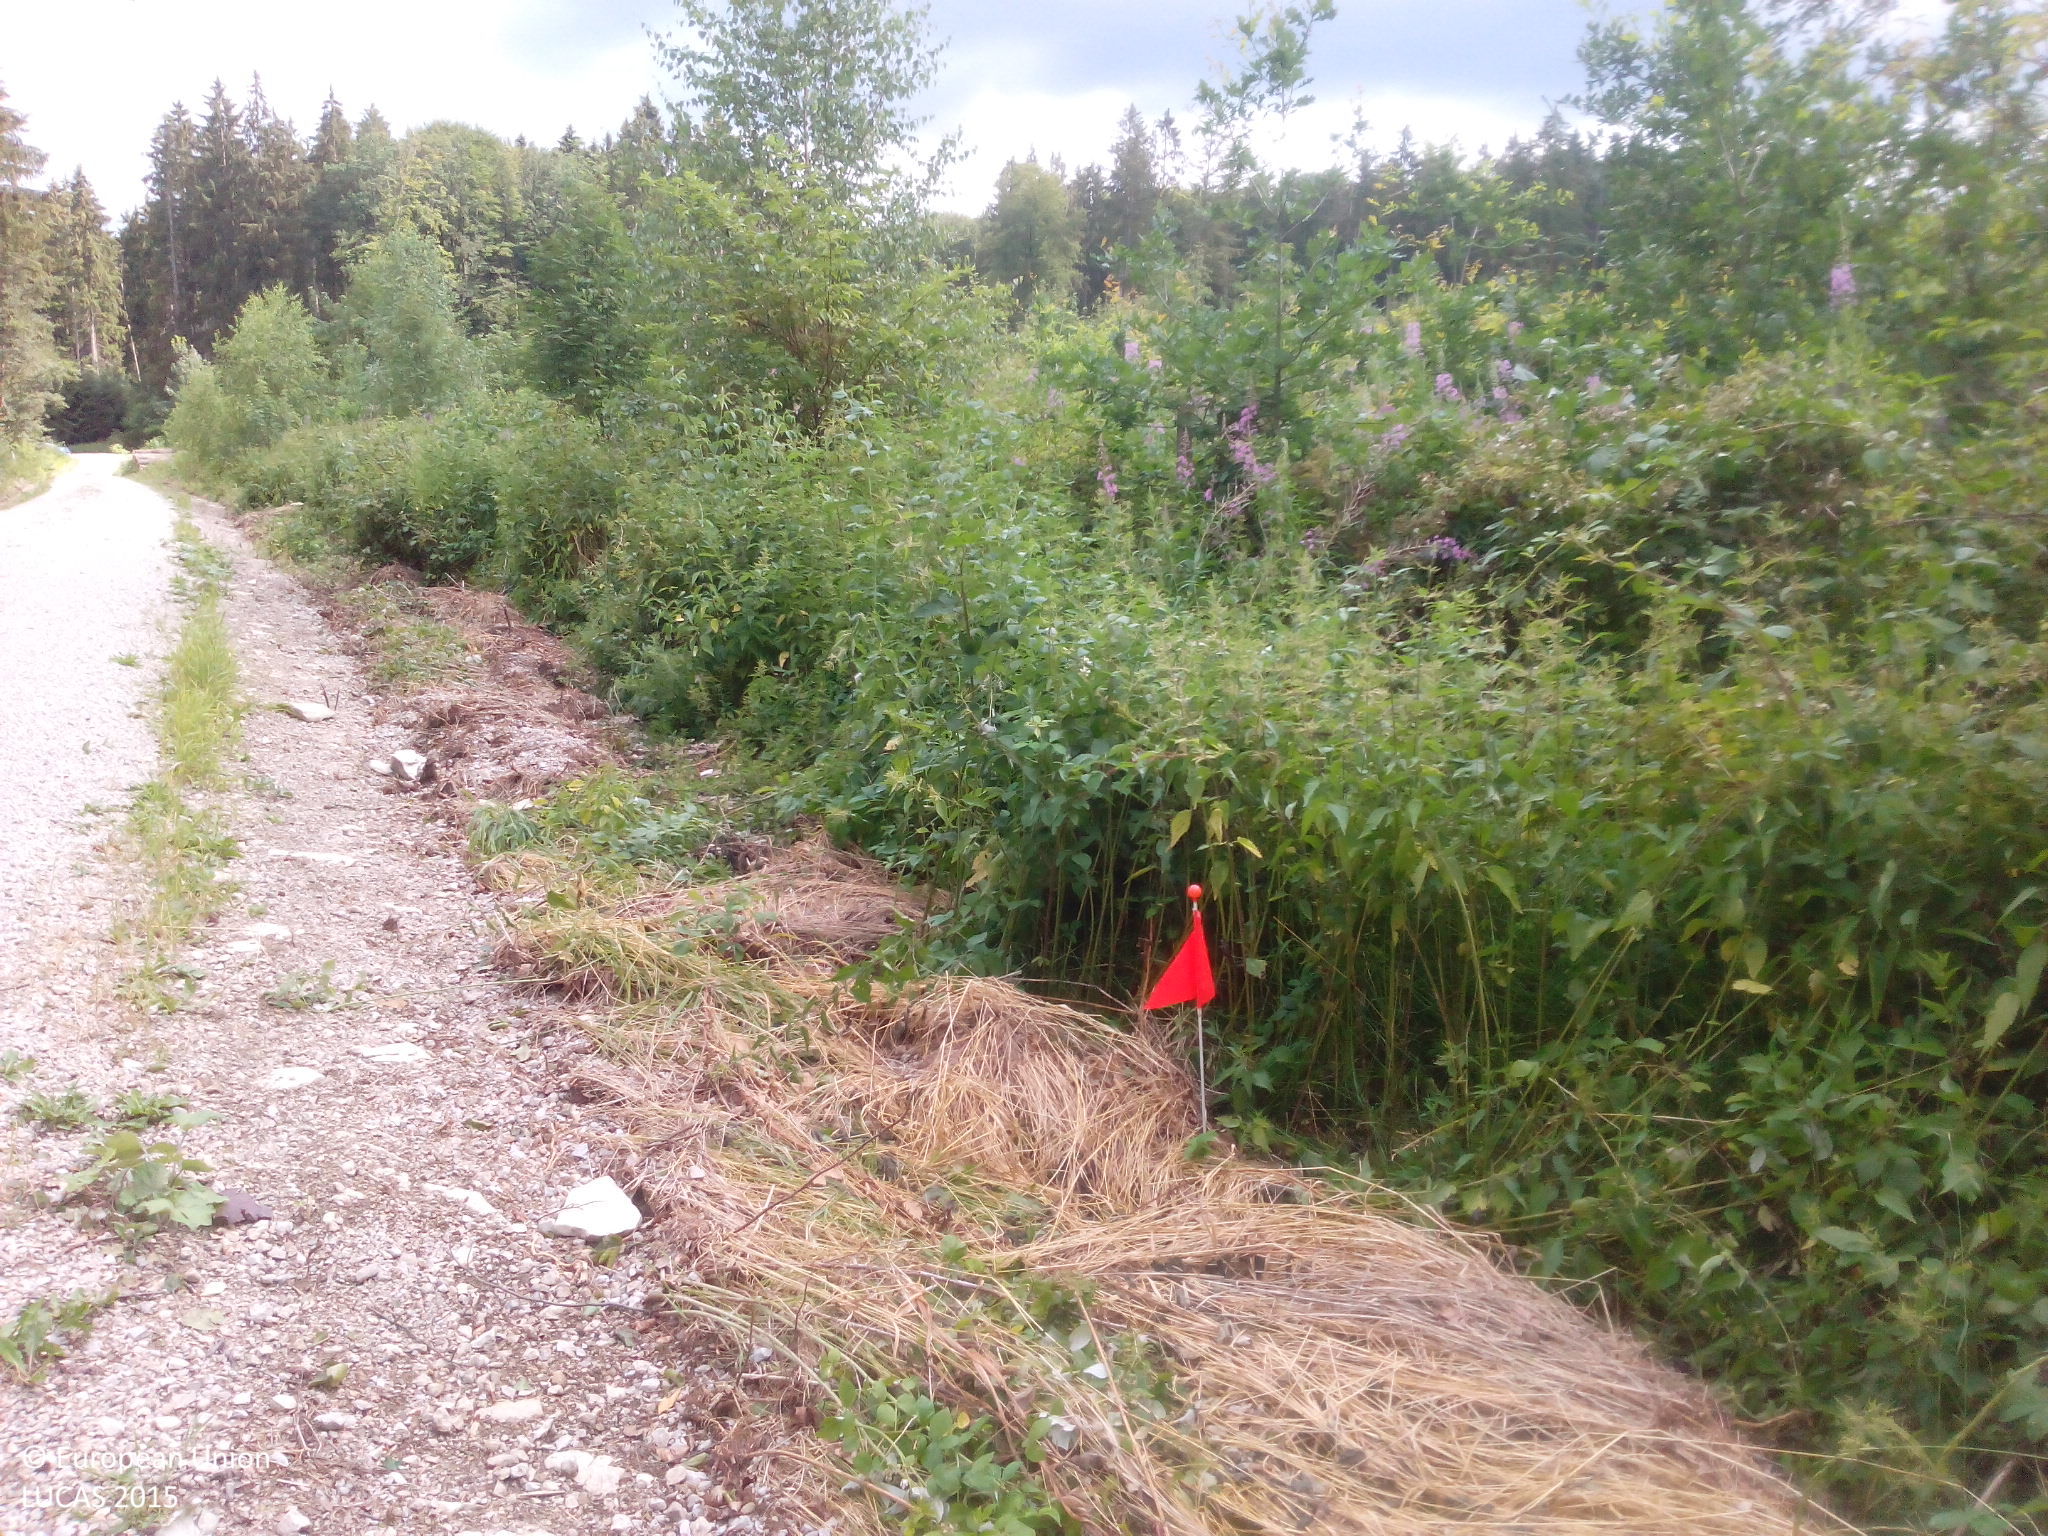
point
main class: Woodland
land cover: Broadleaved woodland
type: mesophytic deciduous forest
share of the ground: 50 - 75 %
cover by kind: broadleaved forest trees 60 %, herbaceous plants 20 %, coniferous forest trees 10 %, lichens and mosses 5 %, unconsolidated bare surface 5 %
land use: Forestry
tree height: > 5 m
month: July
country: DE
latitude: 48.8614
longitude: 11.4852
